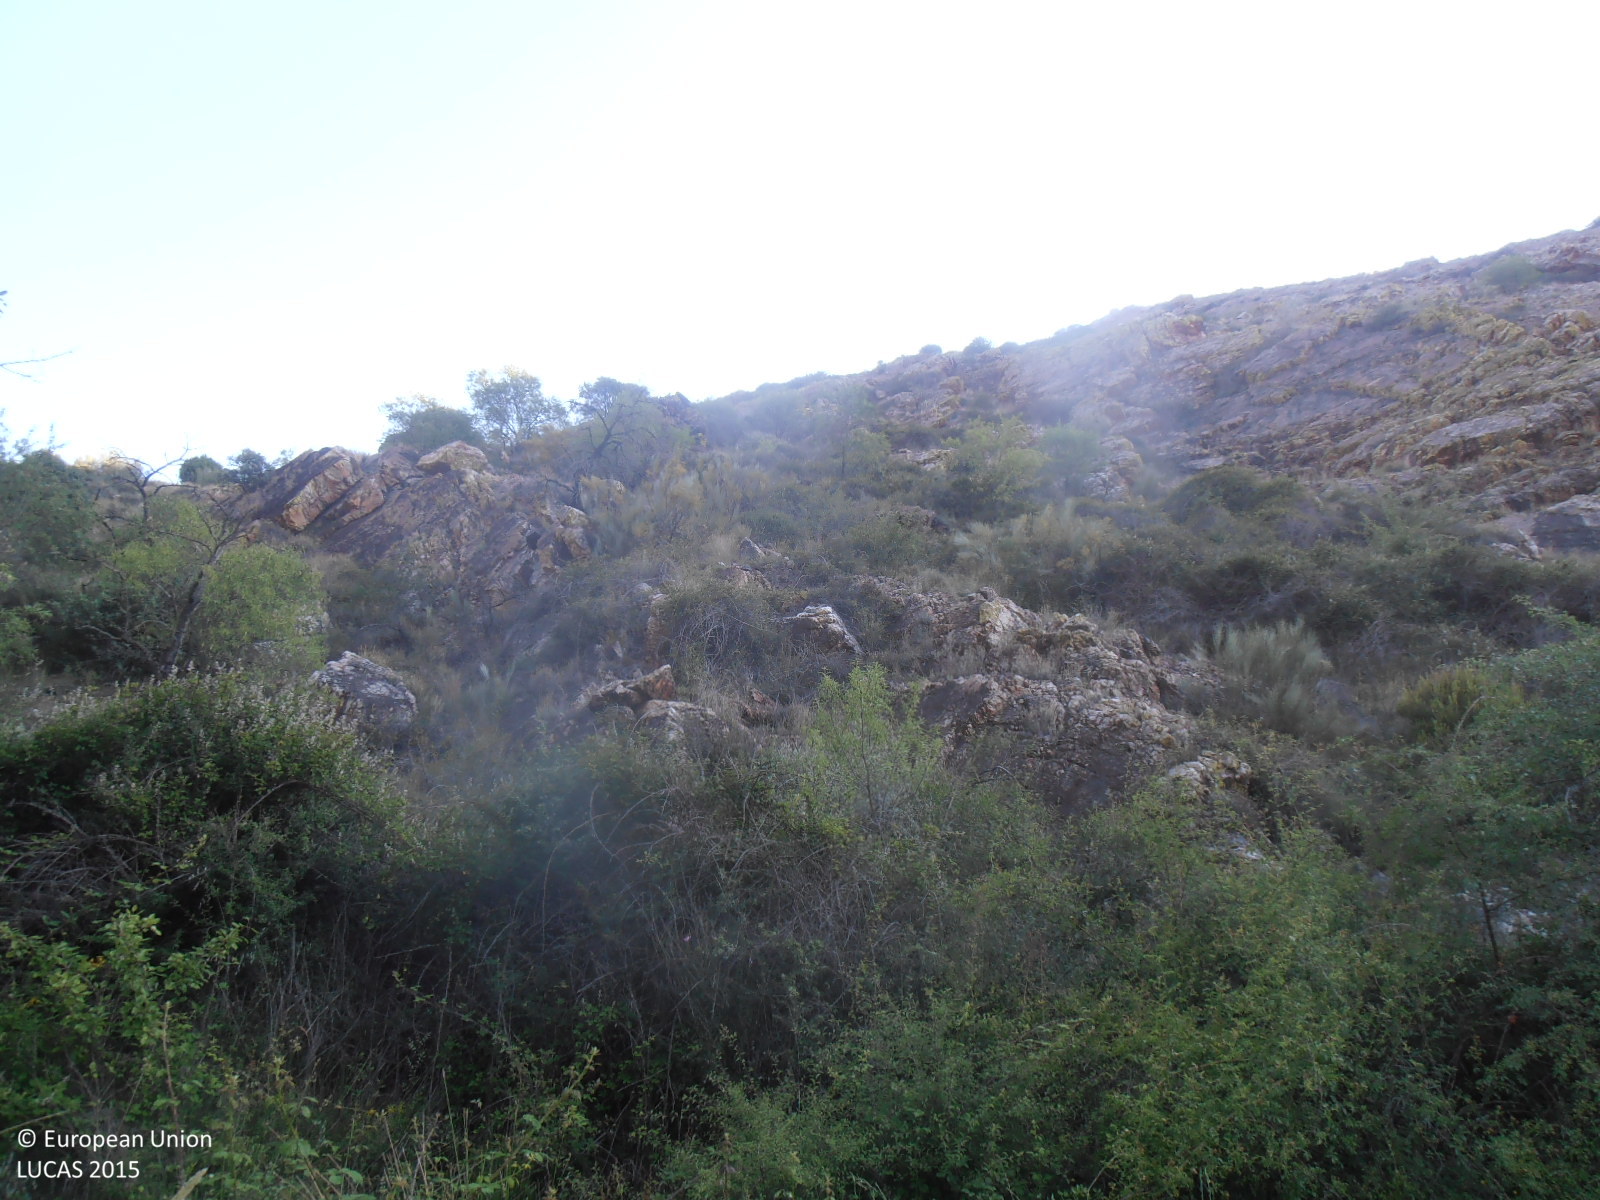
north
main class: Shrubland
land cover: Shrubland with sparse tree cover
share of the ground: > 75 %
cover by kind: shrubs 95 %, broadleaved forest trees 5 %
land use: Semi-natural and natural areas not in use
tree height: > 5 m
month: June
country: ES
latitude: 41.4067
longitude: -1.3998
